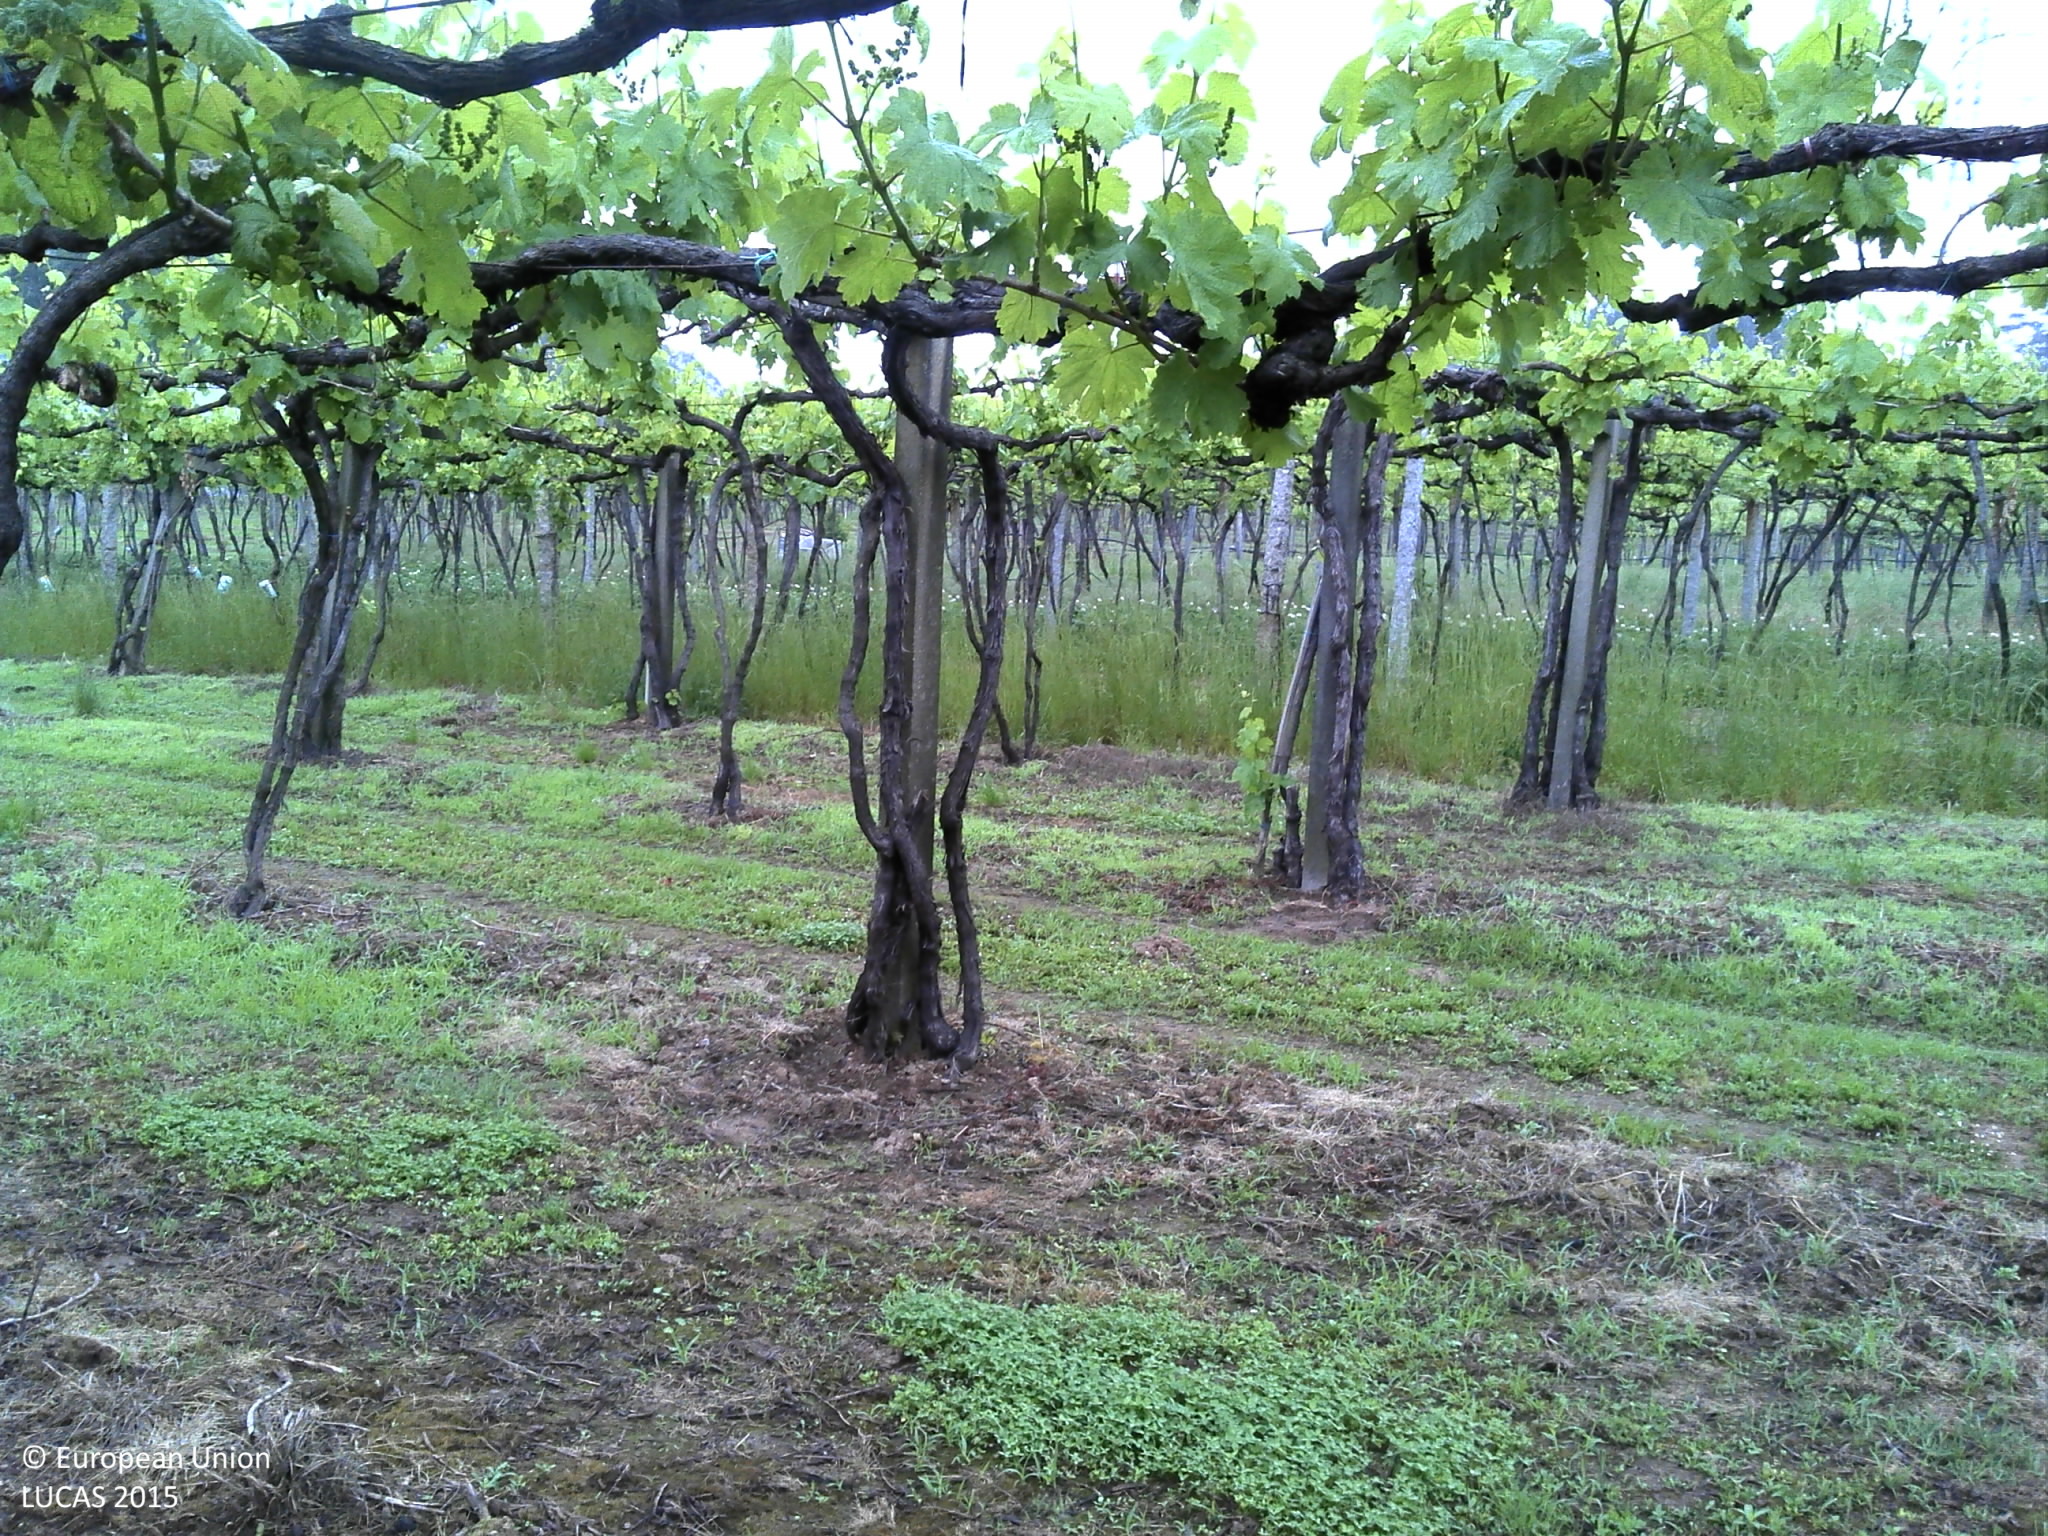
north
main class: Cropland
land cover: Vineyards
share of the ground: 50 - 75 %
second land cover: Grassland without tree/shrub cover
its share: 10 - 25 %
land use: Agriculture (excluding fallow land and kitchen gardens)
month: May
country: PT
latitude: 41.1997
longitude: -8.4530
